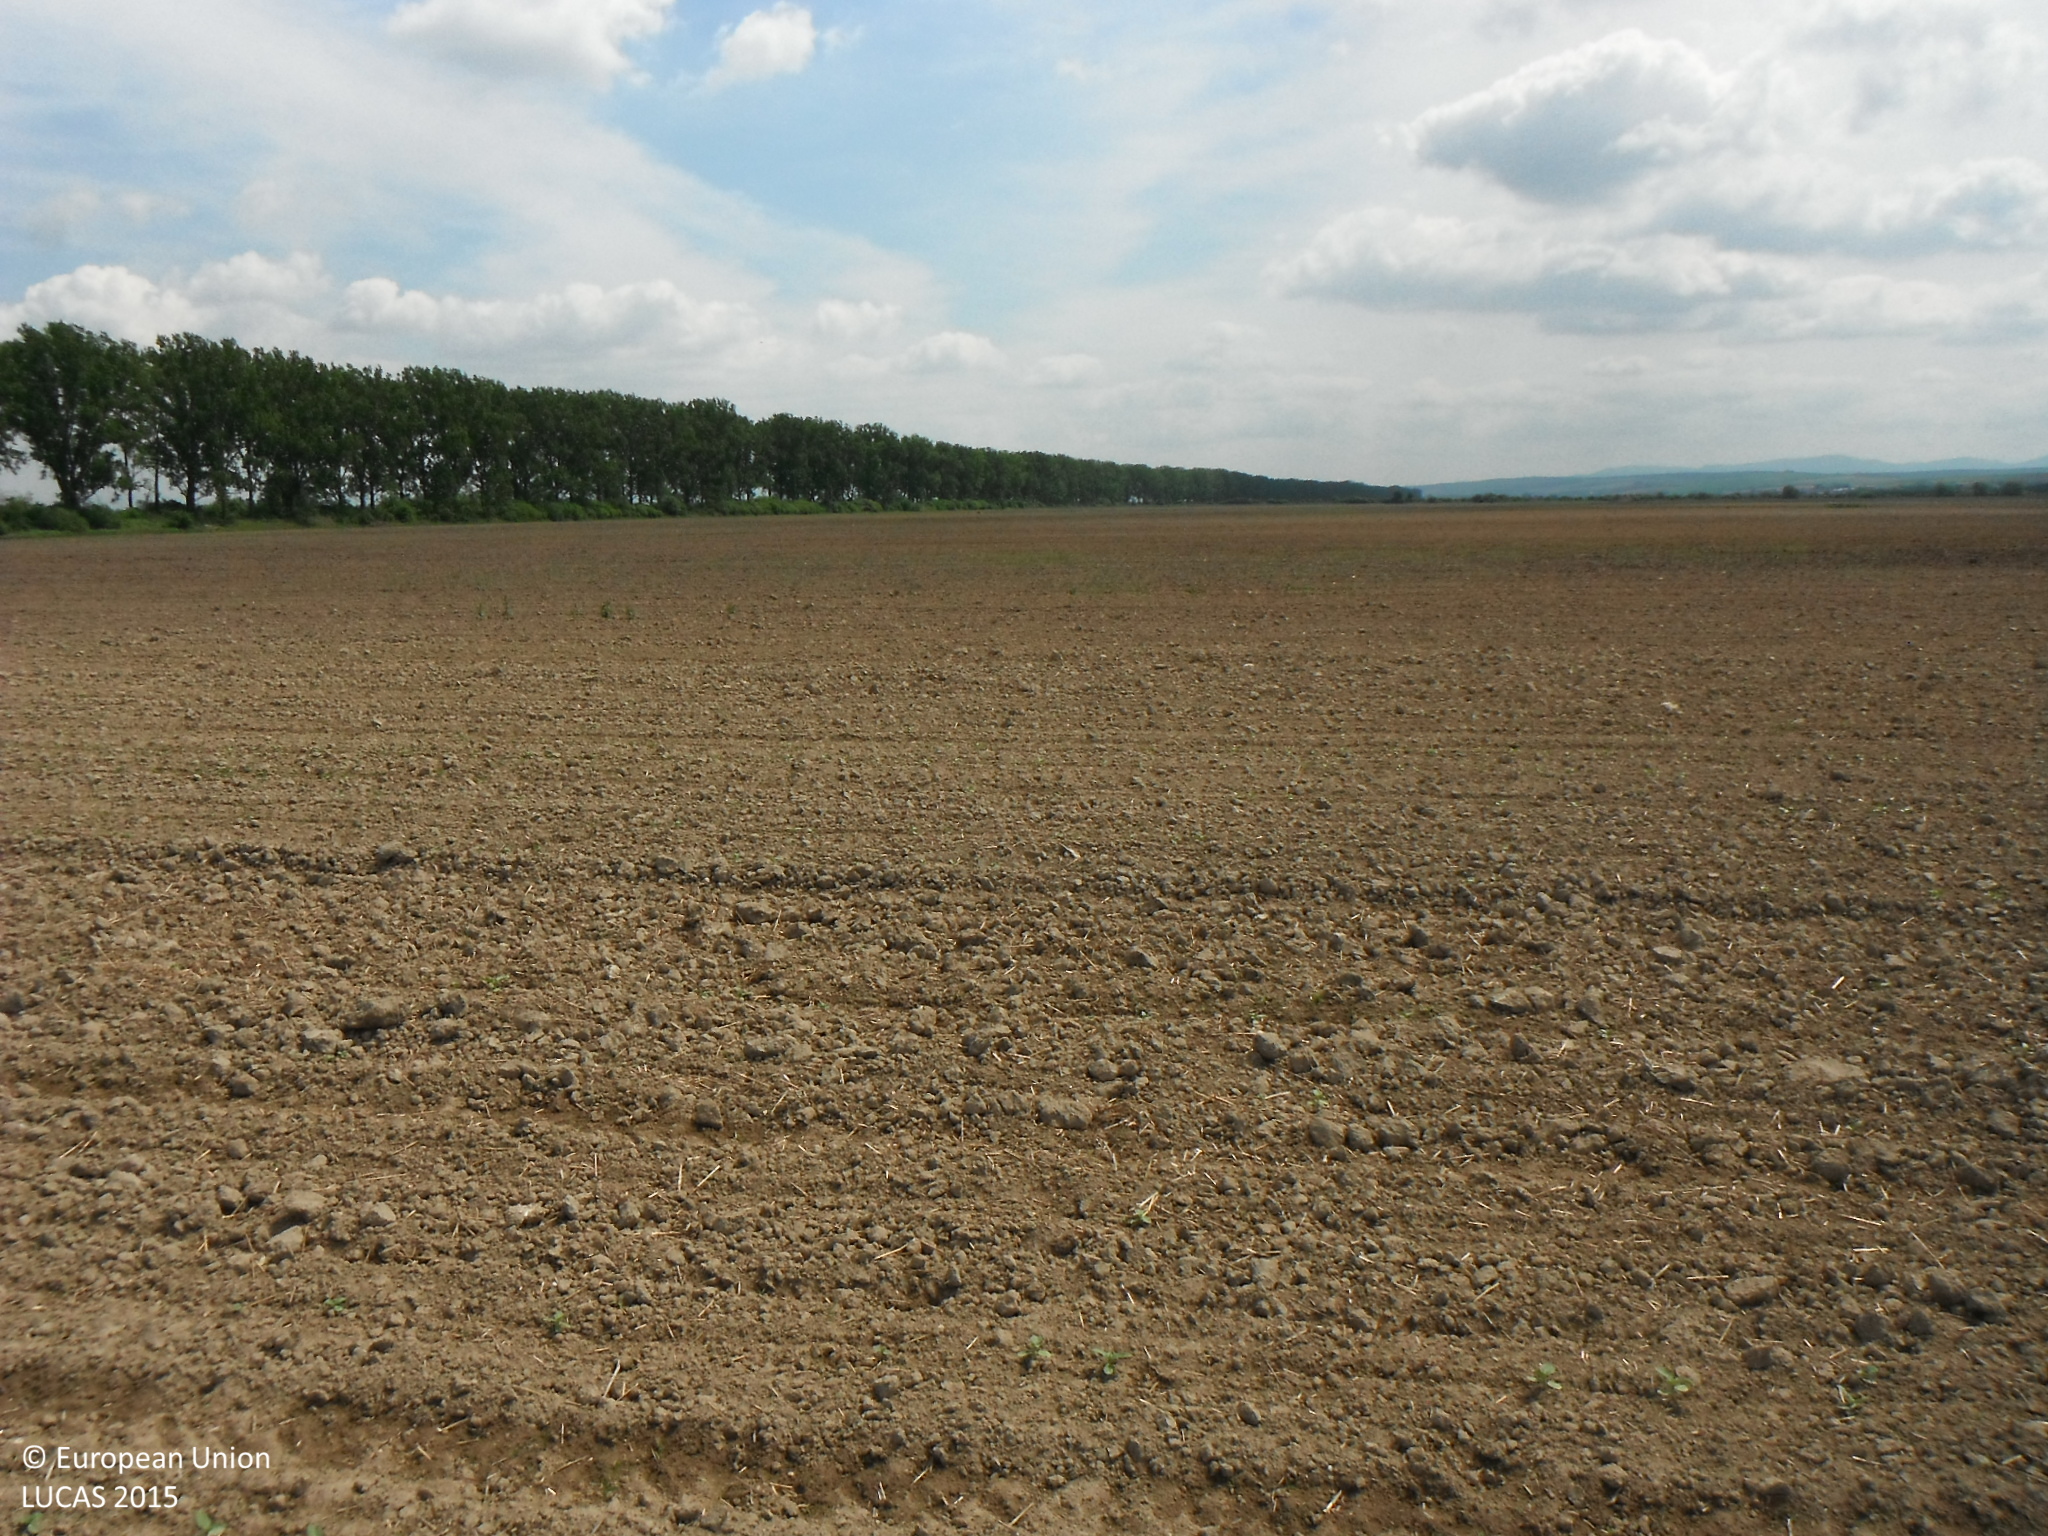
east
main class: Cropland
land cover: Sunflower
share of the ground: < 10 %
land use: Agriculture (excluding fallow land and kitchen gardens)
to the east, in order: Sunflower
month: May
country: SK
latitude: 48.5581
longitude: 21.0296
